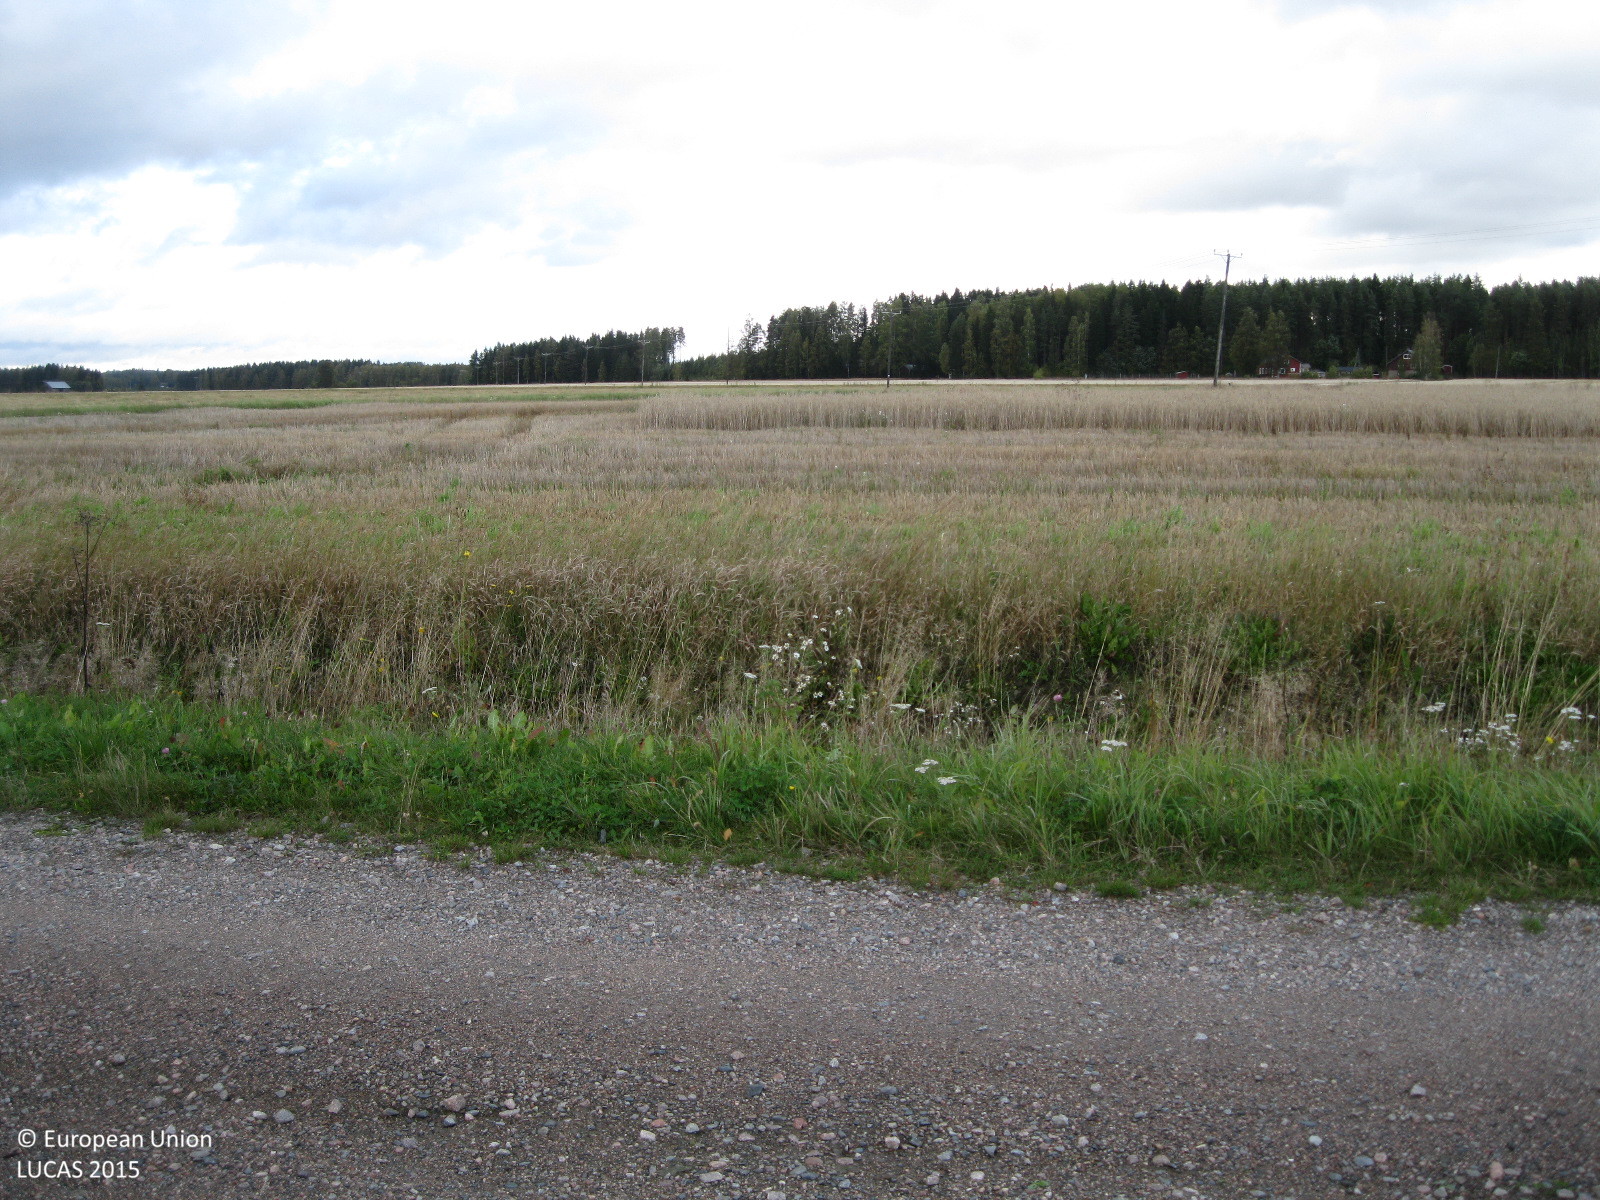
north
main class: Cropland
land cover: Oats
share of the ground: > 75 %
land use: Agriculture (excluding fallow land and kitchen gardens)
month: September
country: FI
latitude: 60.8862
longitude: 24.7569
